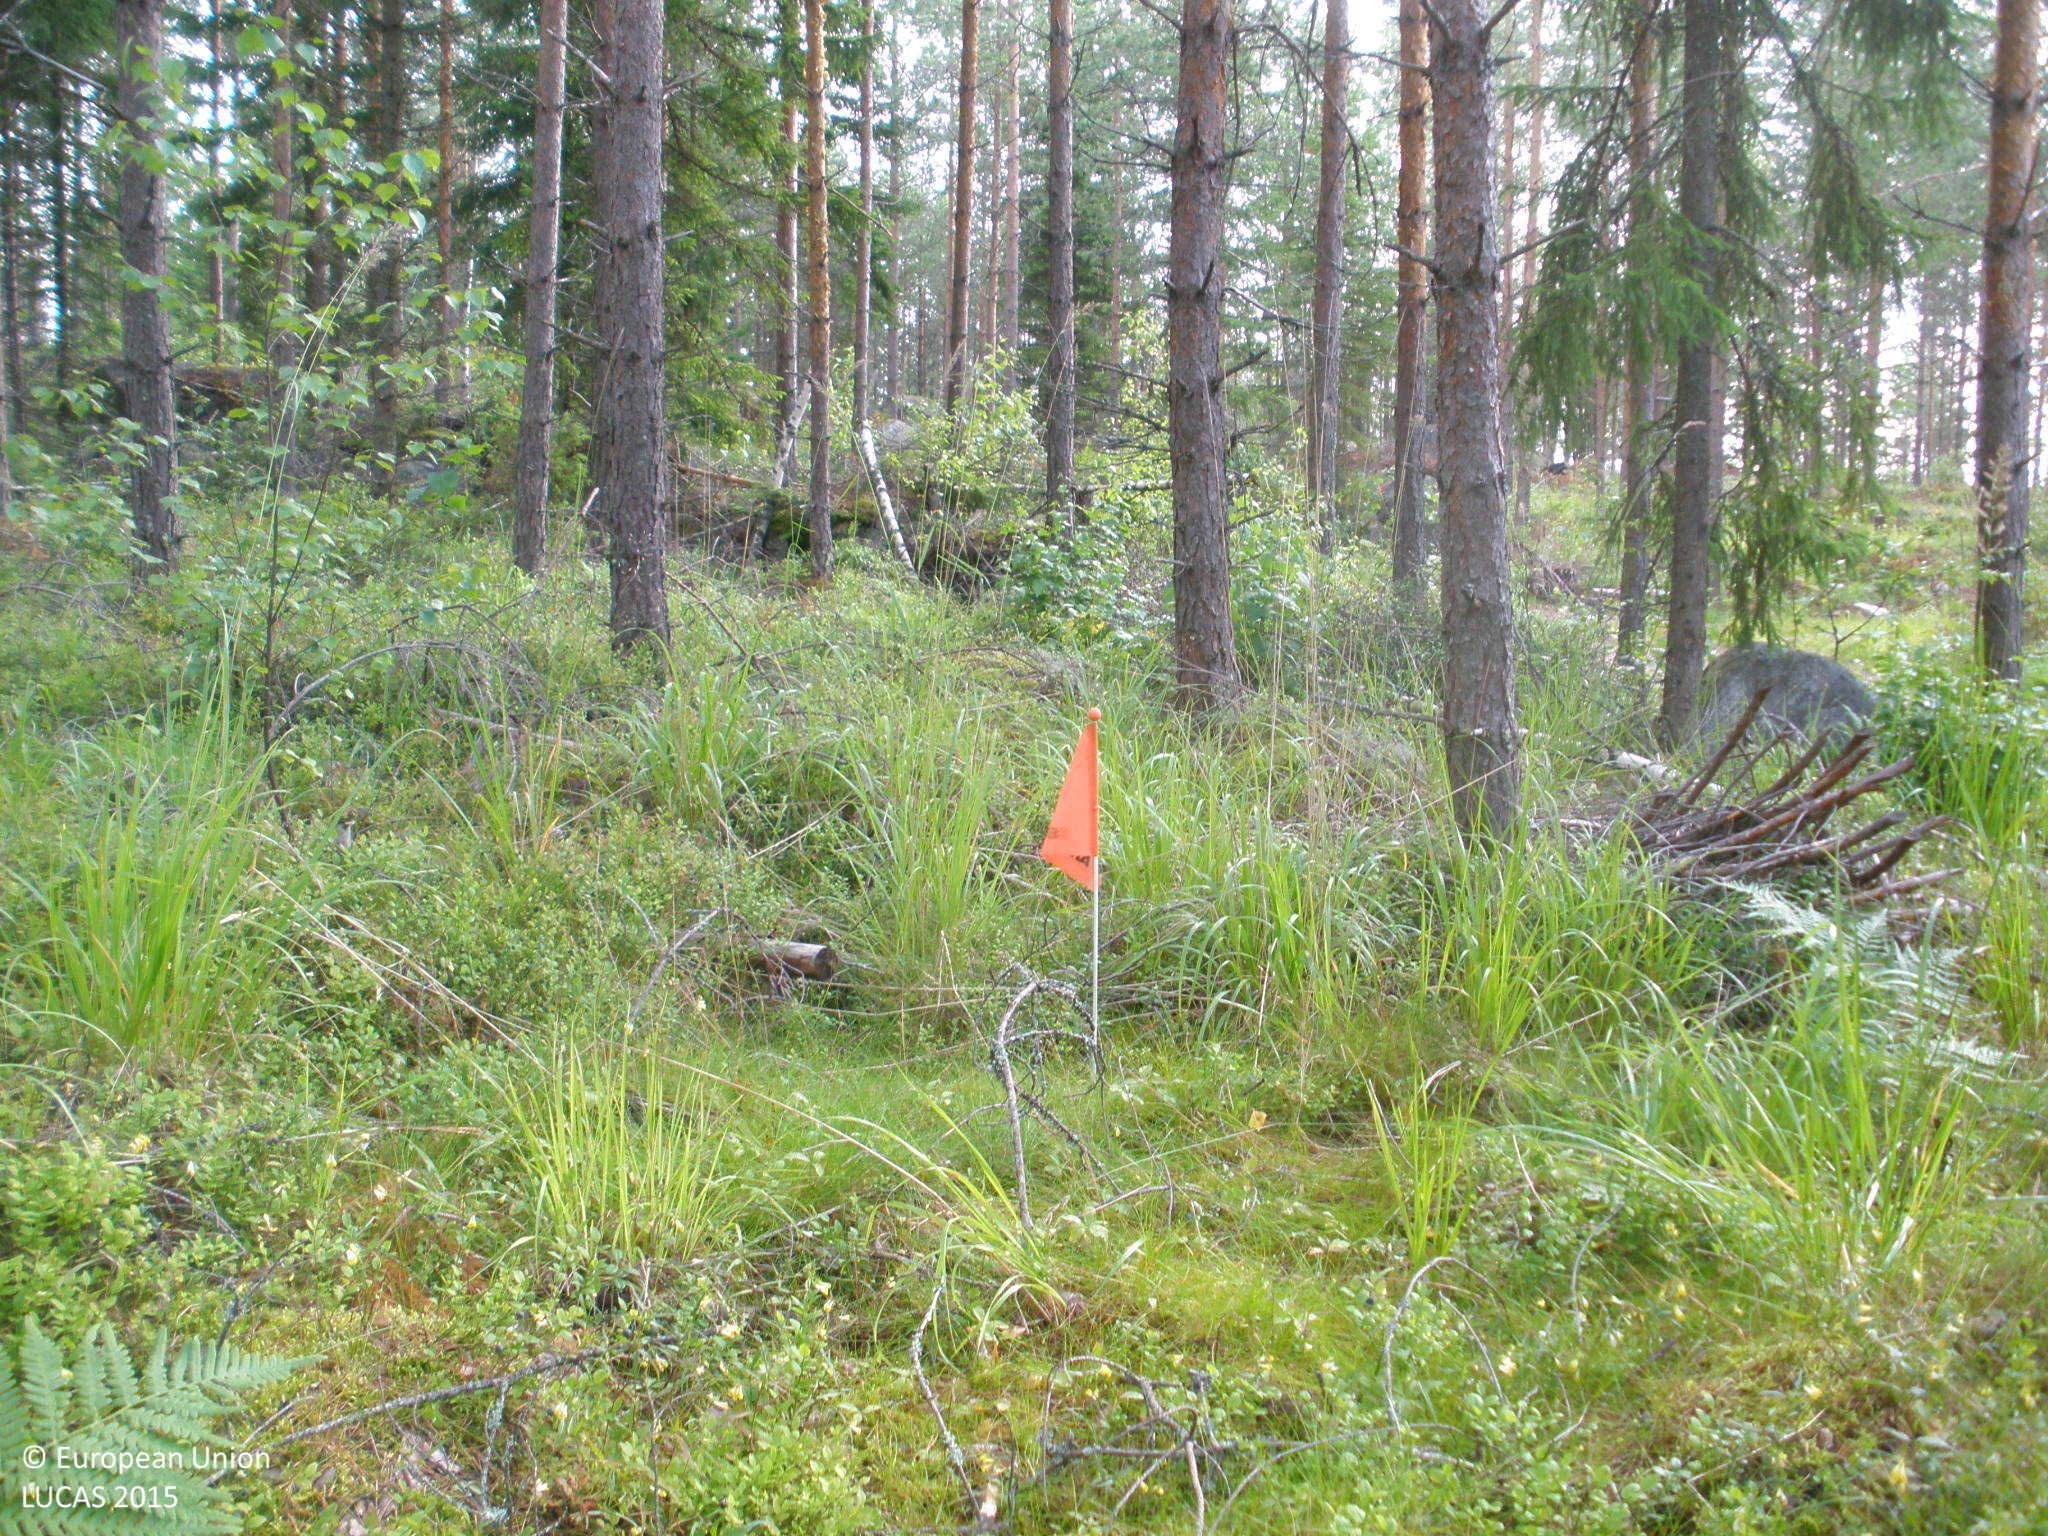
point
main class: Woodland
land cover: Pine dominated coniferous woodland
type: boreal forest
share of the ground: > 75 %
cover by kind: coniferous forest trees 70 %, herbaceous plants 15 %, lichens and mosses 10 %, broadleaved forest trees 5 %
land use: Forestry
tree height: > 5 m
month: July
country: FI
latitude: 60.9749
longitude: 25.1381
